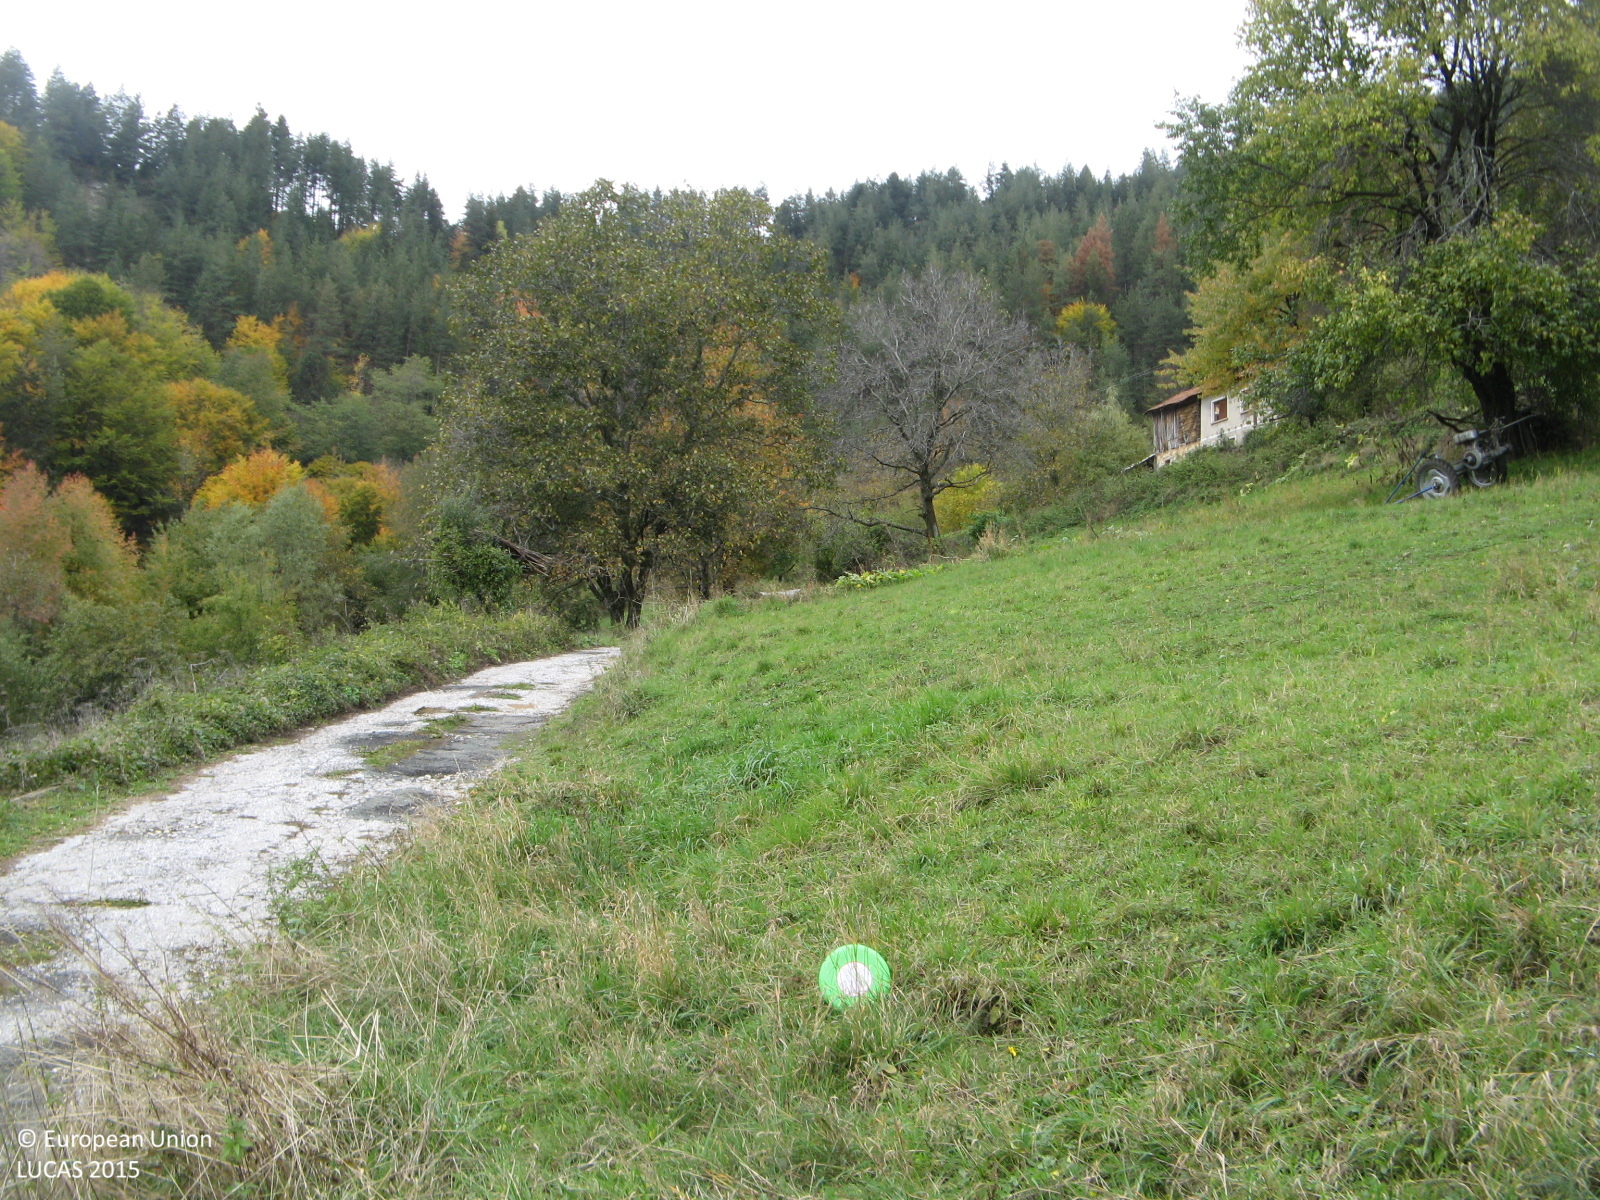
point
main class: Grassland
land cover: Grassland without tree/shrub cover
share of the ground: > 75 %
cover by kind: herbaceous plants 100 %
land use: Agriculture (excluding fallow land and kitchen gardens)
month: October
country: BG
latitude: 41.5979
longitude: 24.7906
